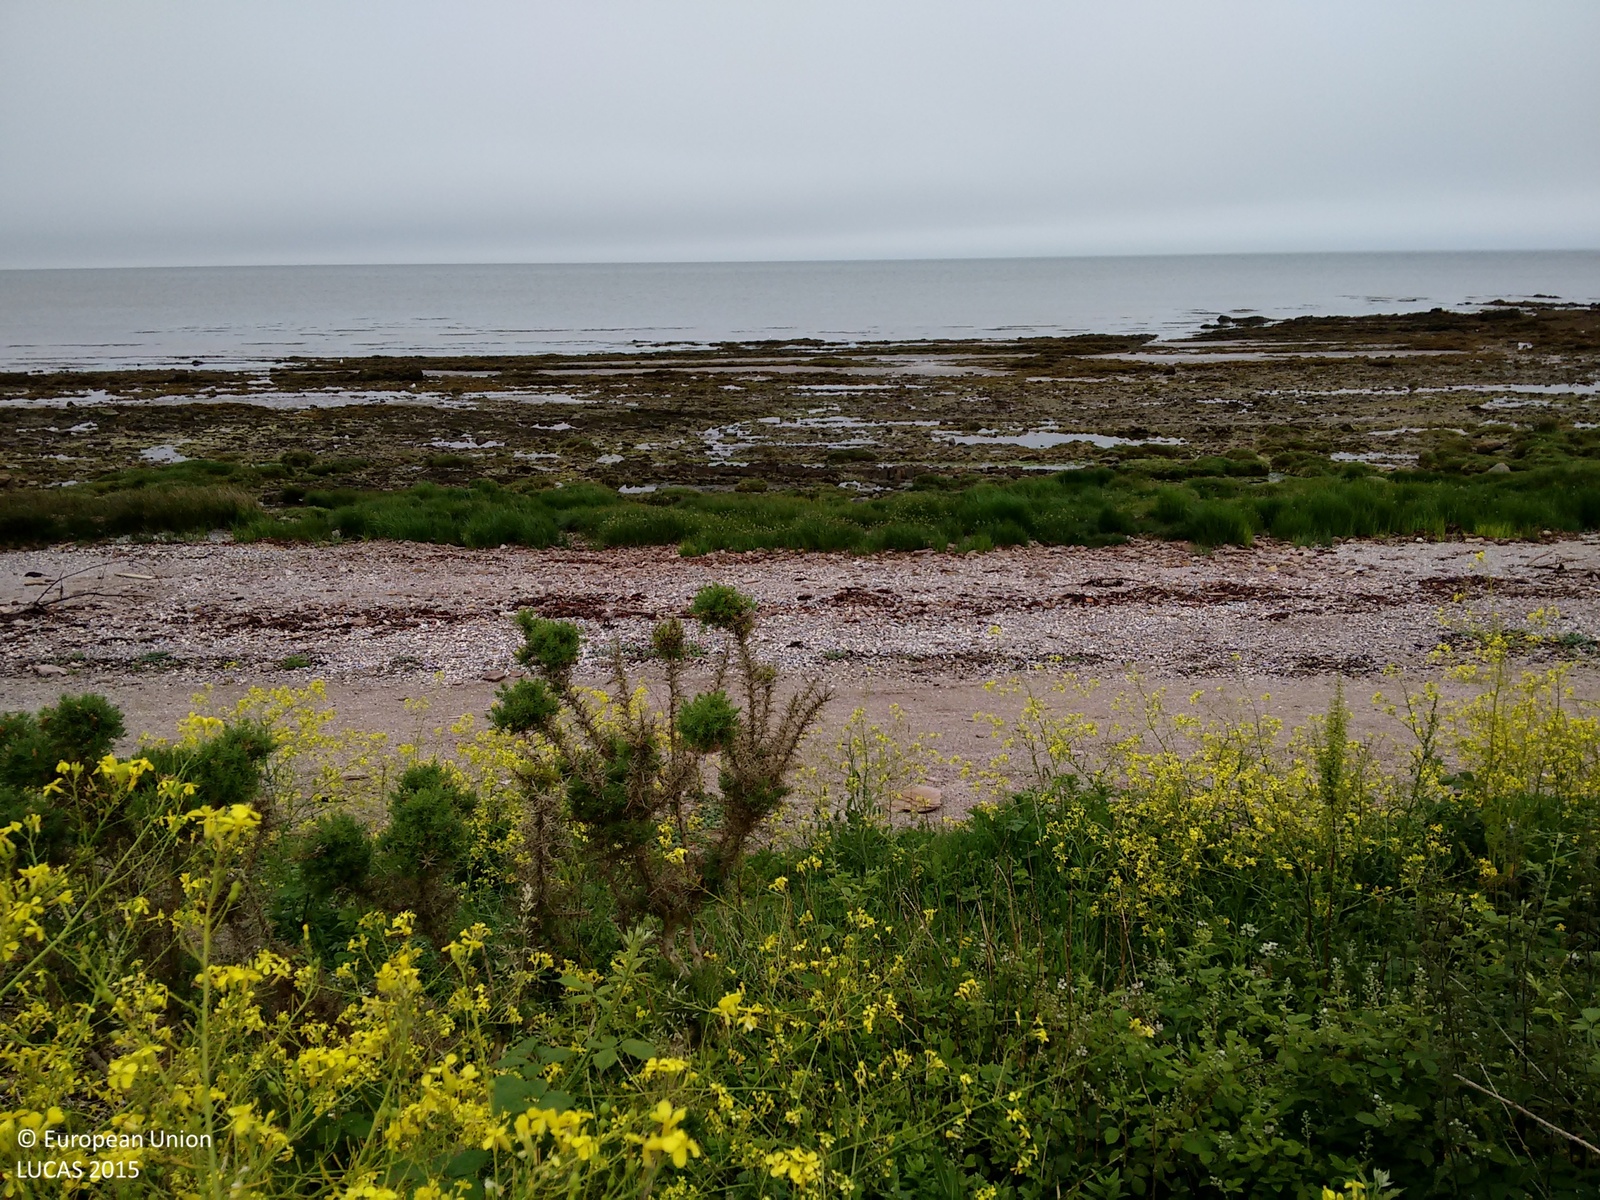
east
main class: Grassland
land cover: Grassland without tree/shrub cover
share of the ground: > 75 %
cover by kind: herbaceous plants 100 %
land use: Residential
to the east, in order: Grassland without tree/shrub cover; Artificial constructions; Spontaneously vegetated surfaces; Sand; Intertidal flats
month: July
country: GB
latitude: 54.8754
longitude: -3.5947
